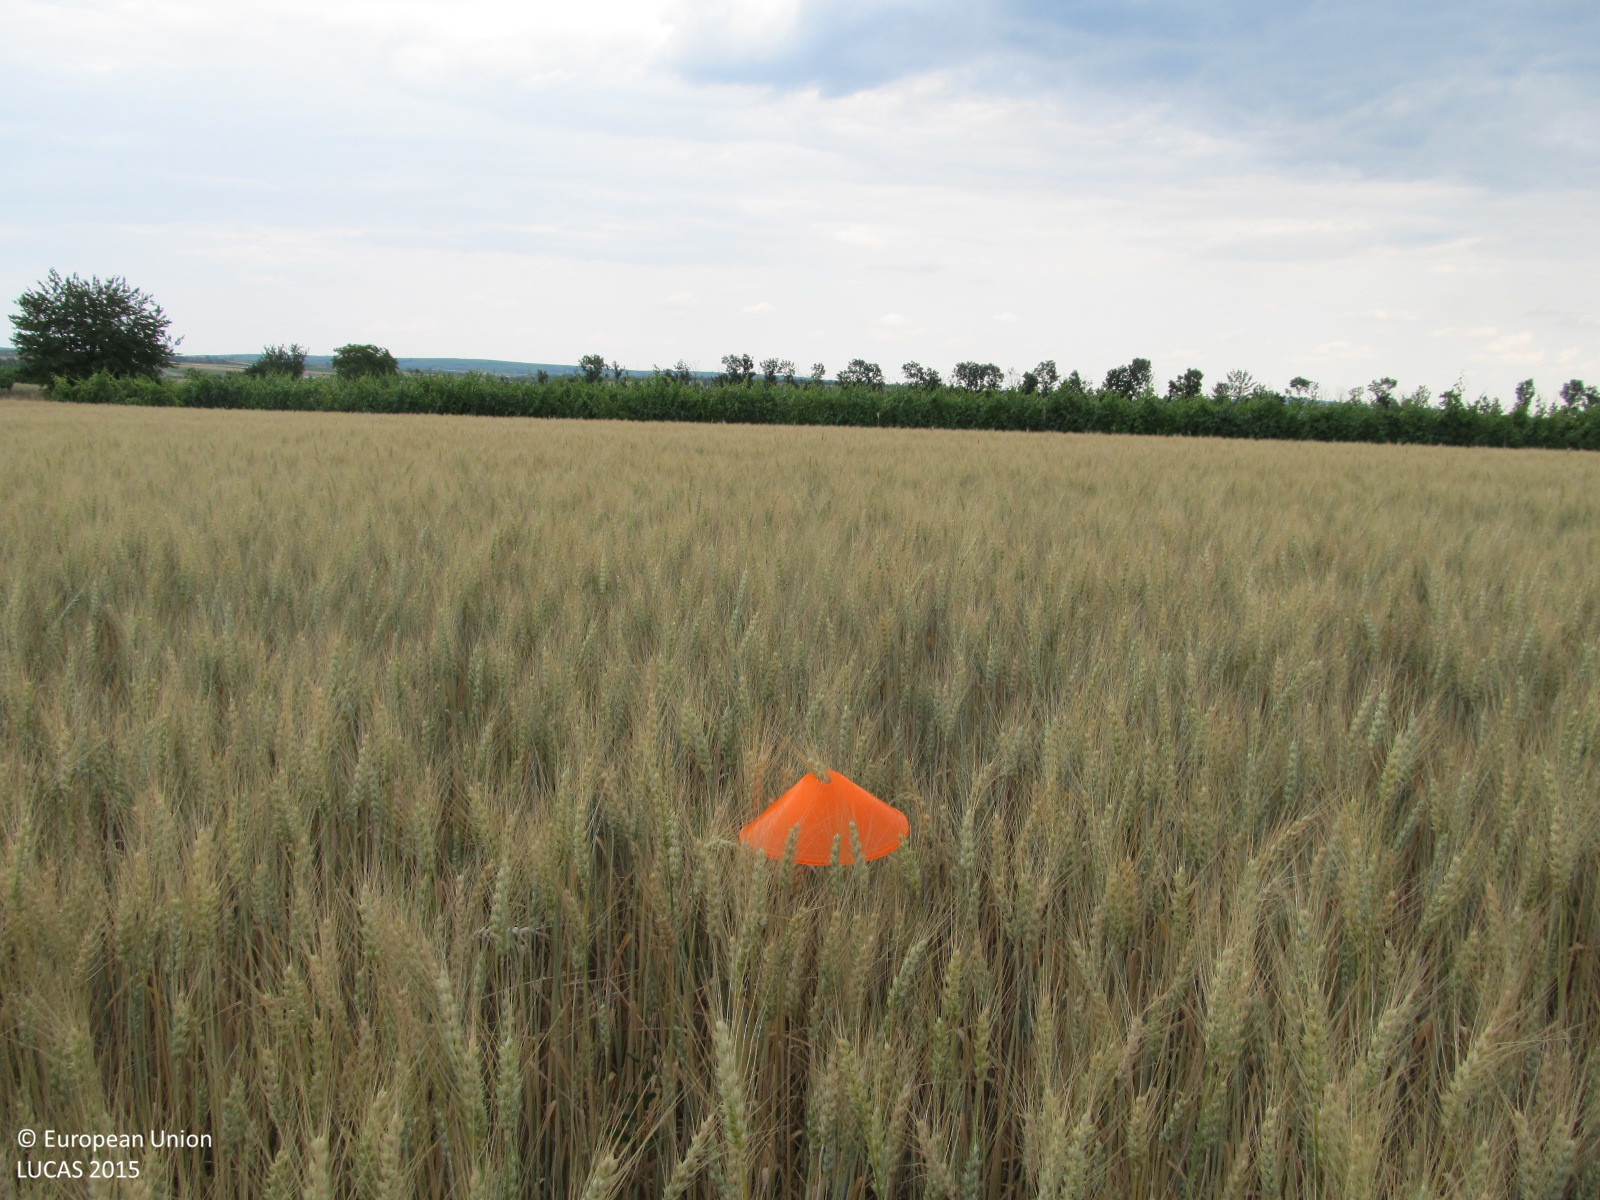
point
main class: Cropland
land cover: Common wheat
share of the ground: > 75 %
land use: Agriculture (excluding fallow land and kitchen gardens)
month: June
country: AT
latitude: 48.7306
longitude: 15.9456
